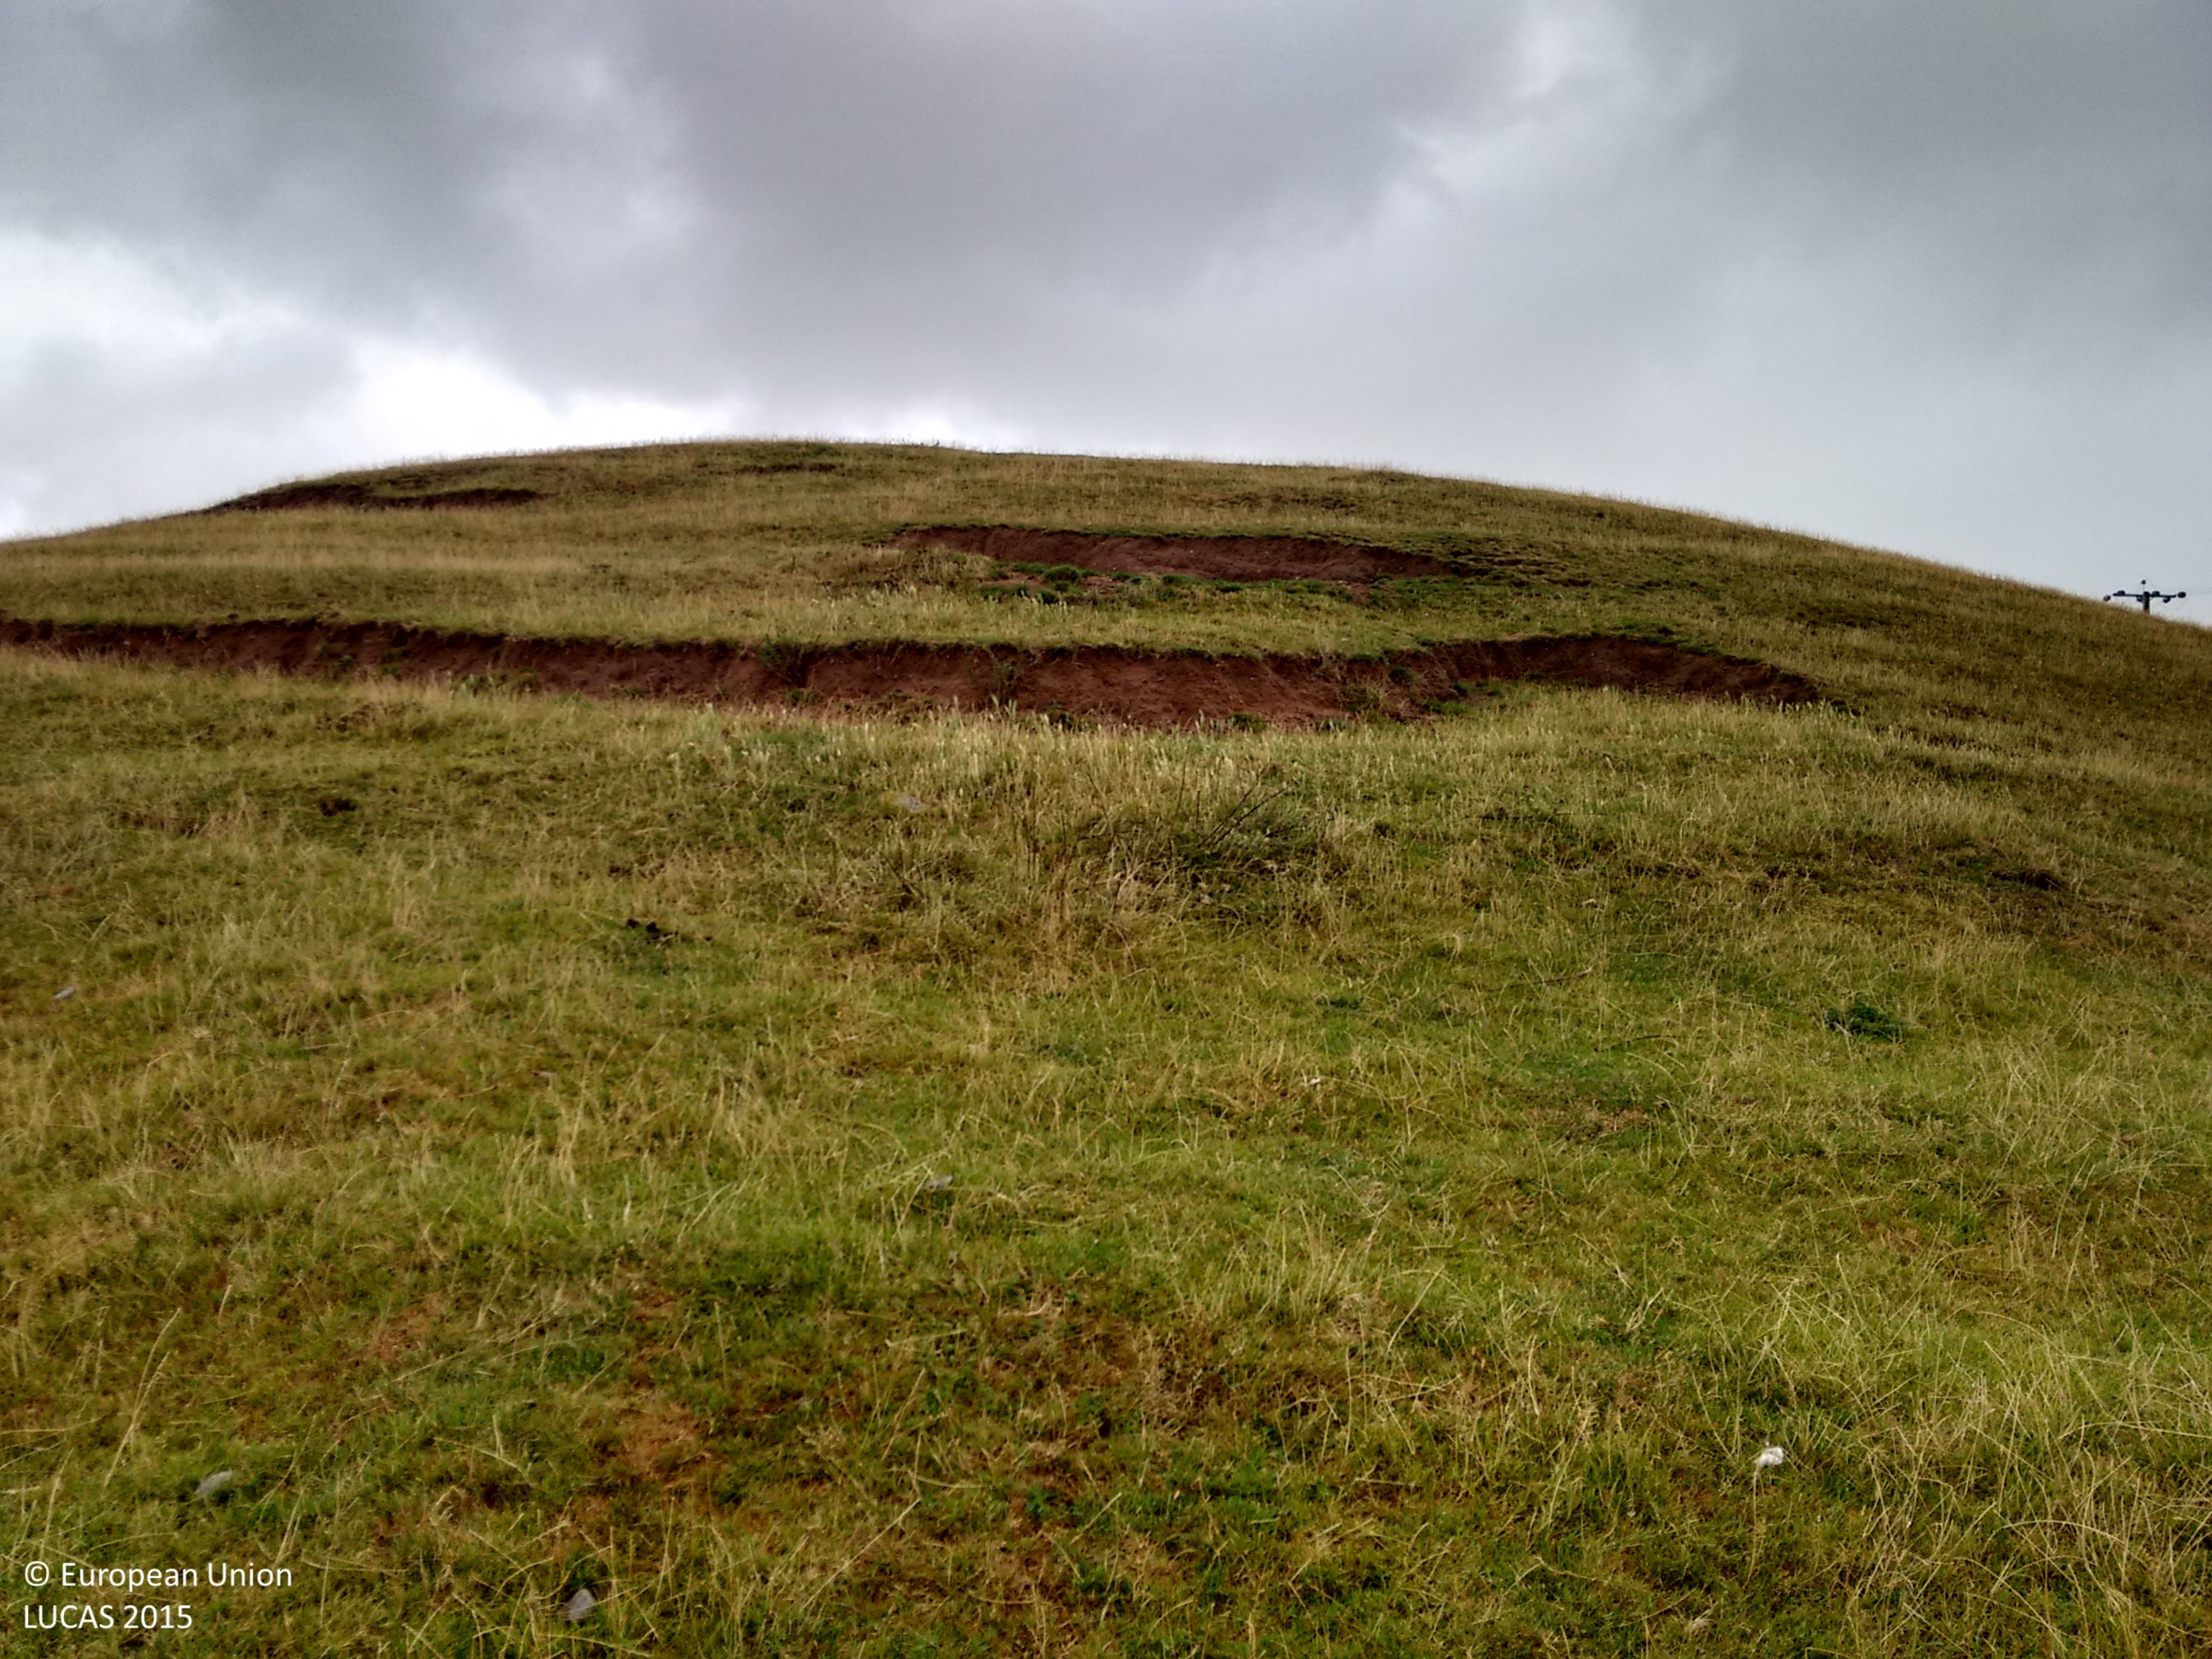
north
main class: Grassland
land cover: Grassland without tree/shrub cover
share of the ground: > 75 %
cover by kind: herbaceous plants 100 %
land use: Agriculture (excluding fallow land and kitchen gardens)
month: August
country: GB
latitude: 53.3067
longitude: -3.4238
